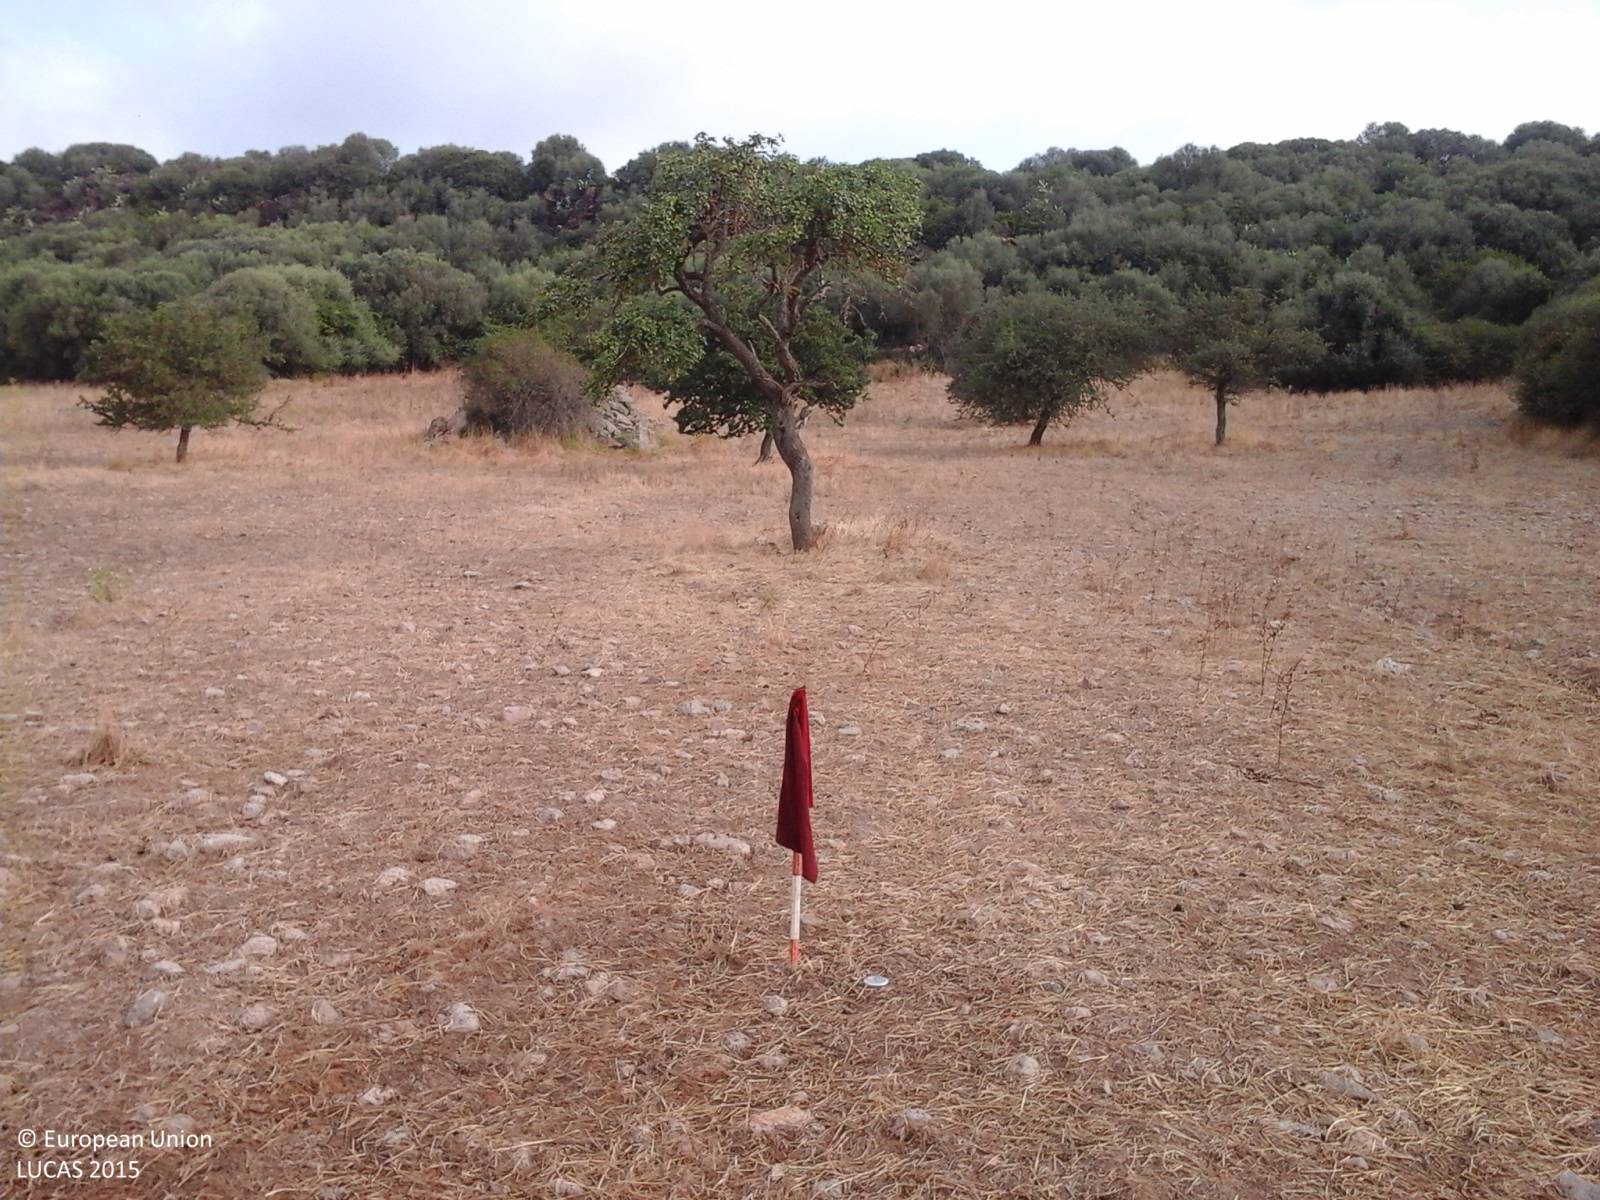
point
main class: Grassland
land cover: Grassland without tree/shrub cover
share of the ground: < 10 %
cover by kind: herbaceous plants 100 %
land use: Agriculture (excluding fallow land and kitchen gardens)
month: July
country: IT
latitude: 40.6411
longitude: 8.8822
